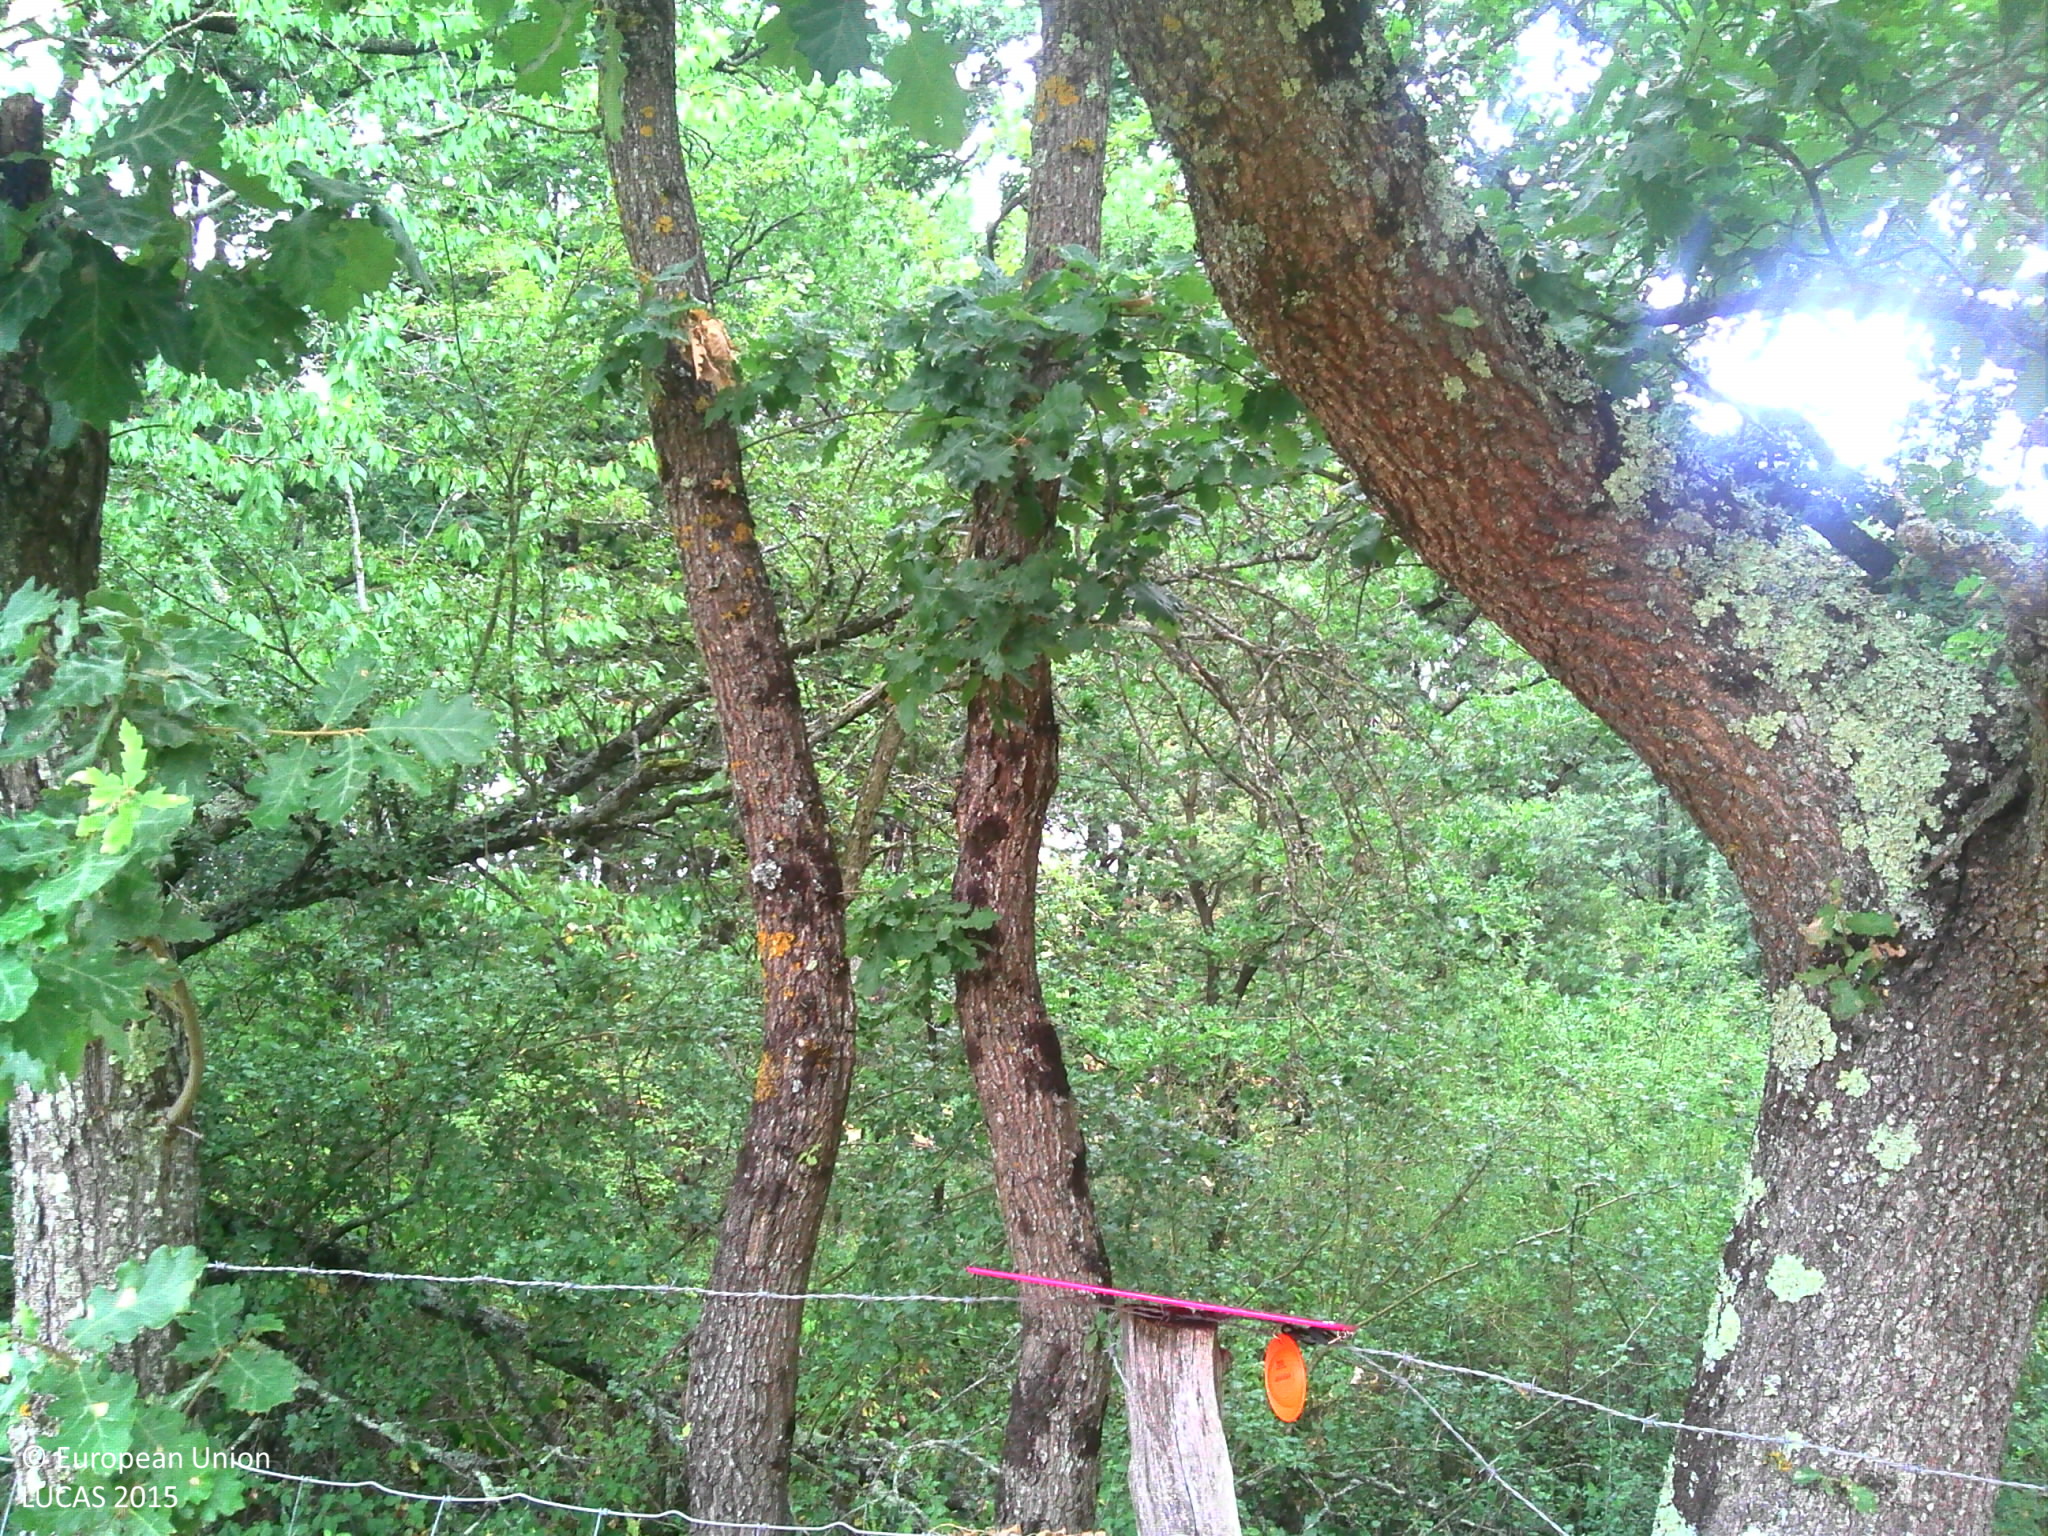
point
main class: Woodland
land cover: Broadleaved woodland
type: mesophytic deciduous forest
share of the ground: > 75 %
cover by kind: broadleaved forest trees 100 %
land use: Forestry
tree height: > 5 m
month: July
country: FR
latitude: 43.9713
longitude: 0.9359
